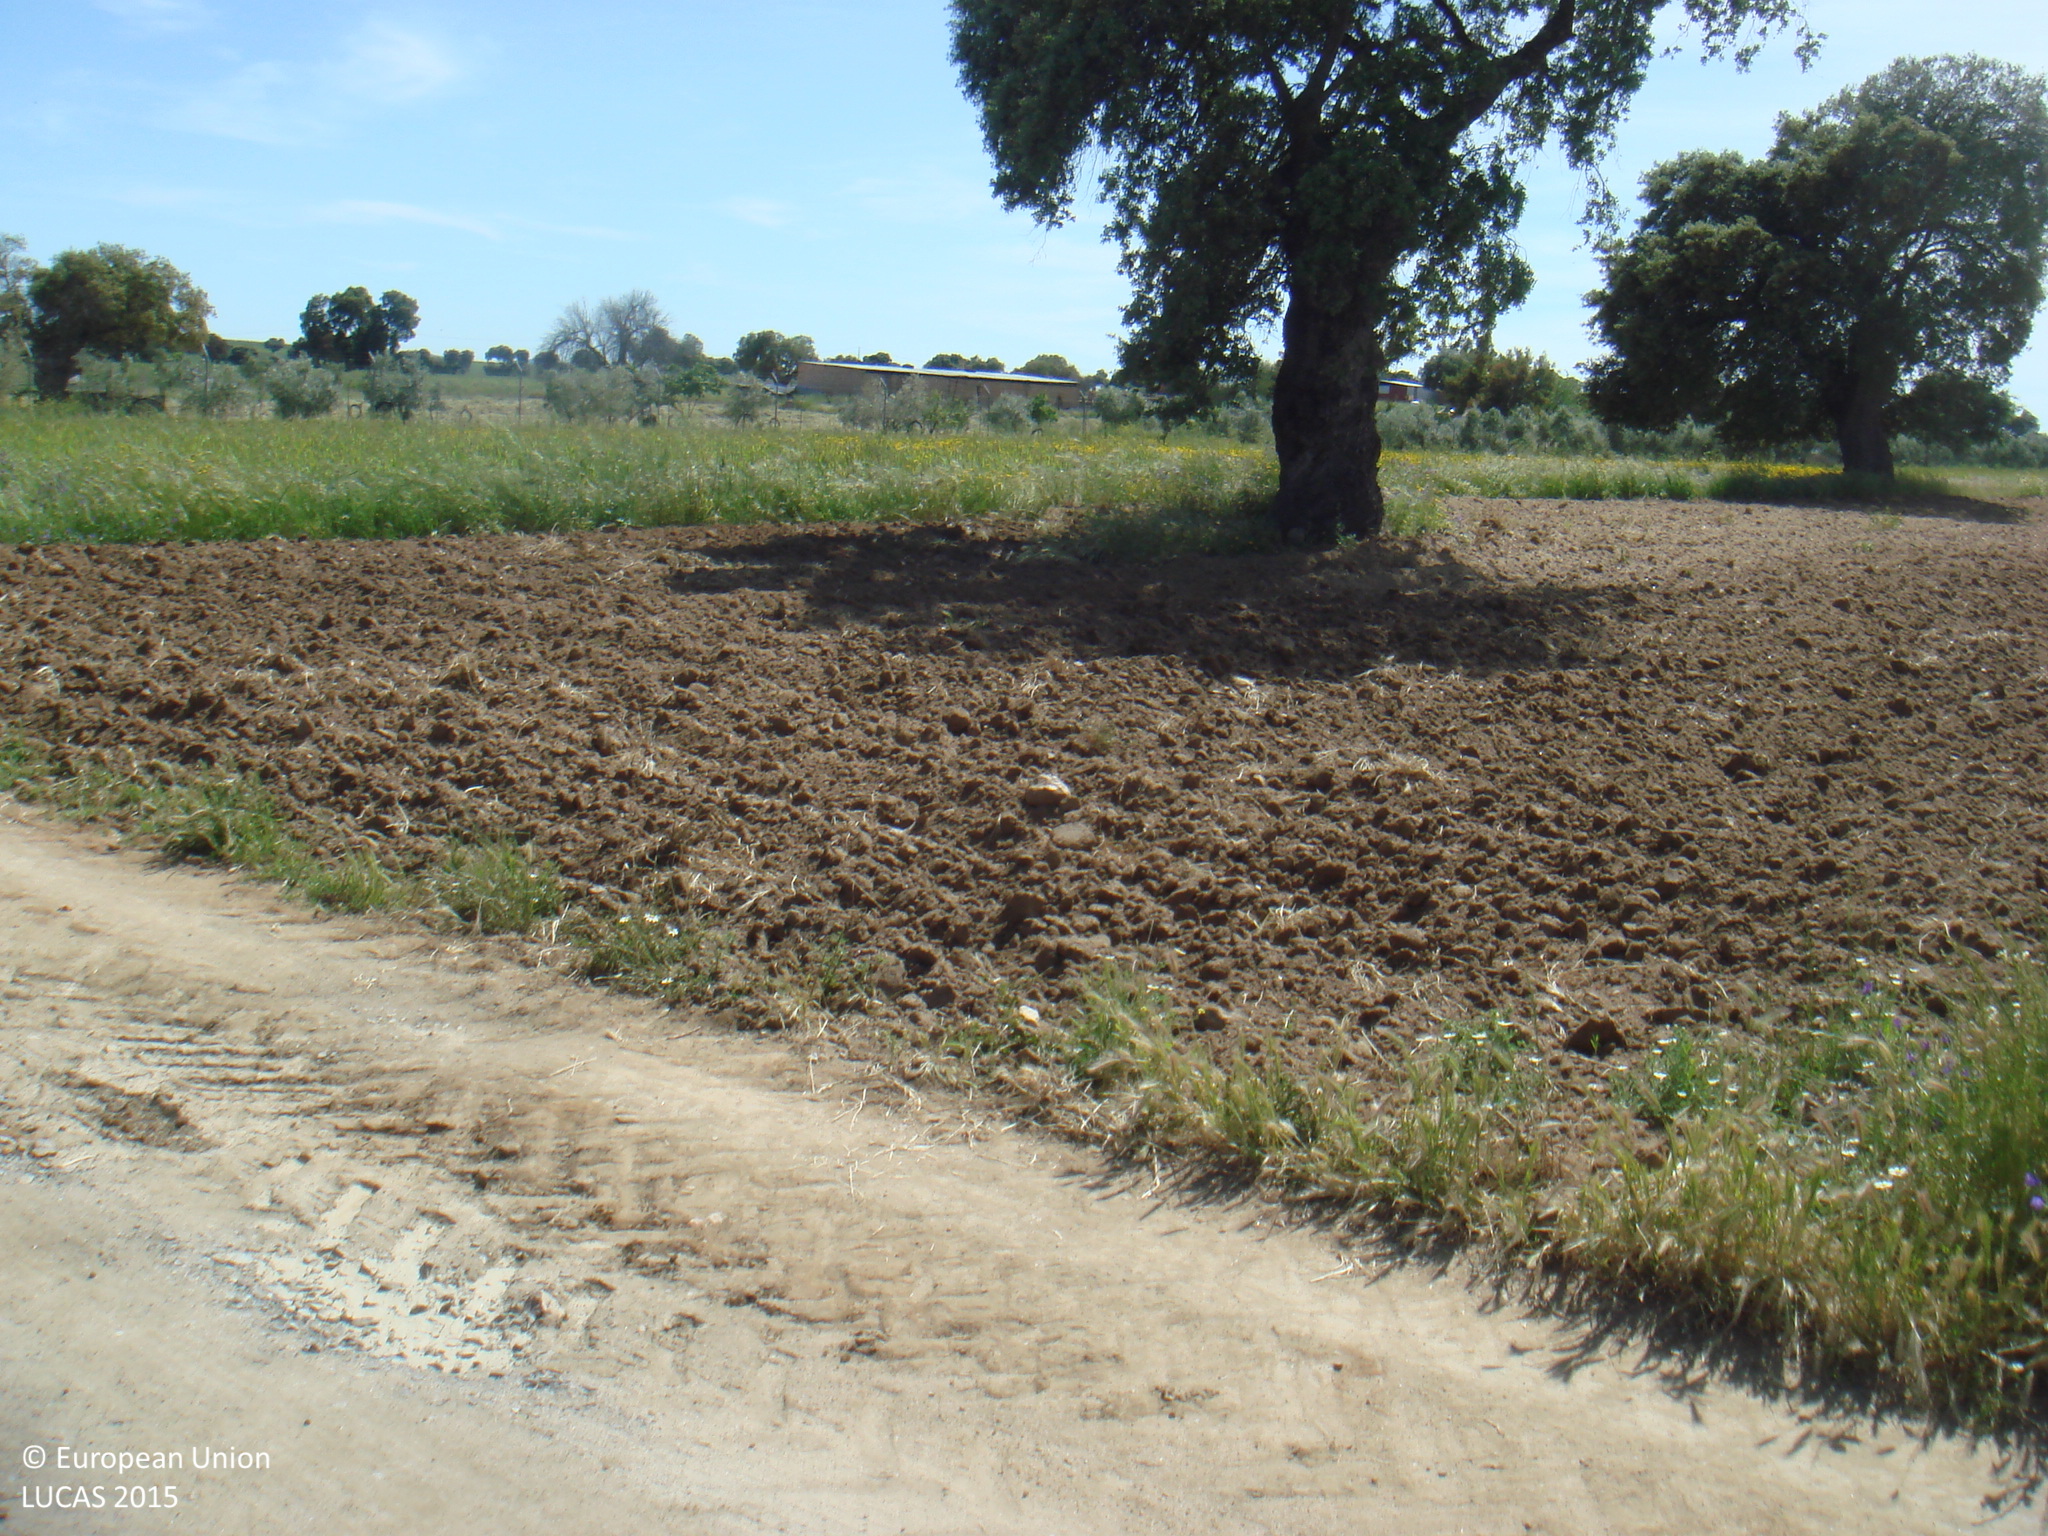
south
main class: Cropland
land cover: Mixed cereals for fodder
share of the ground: 25 - 50 %
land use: Agriculture (excluding fallow land and kitchen gardens)
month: April
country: ES
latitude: 38.4804
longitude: -5.1263
